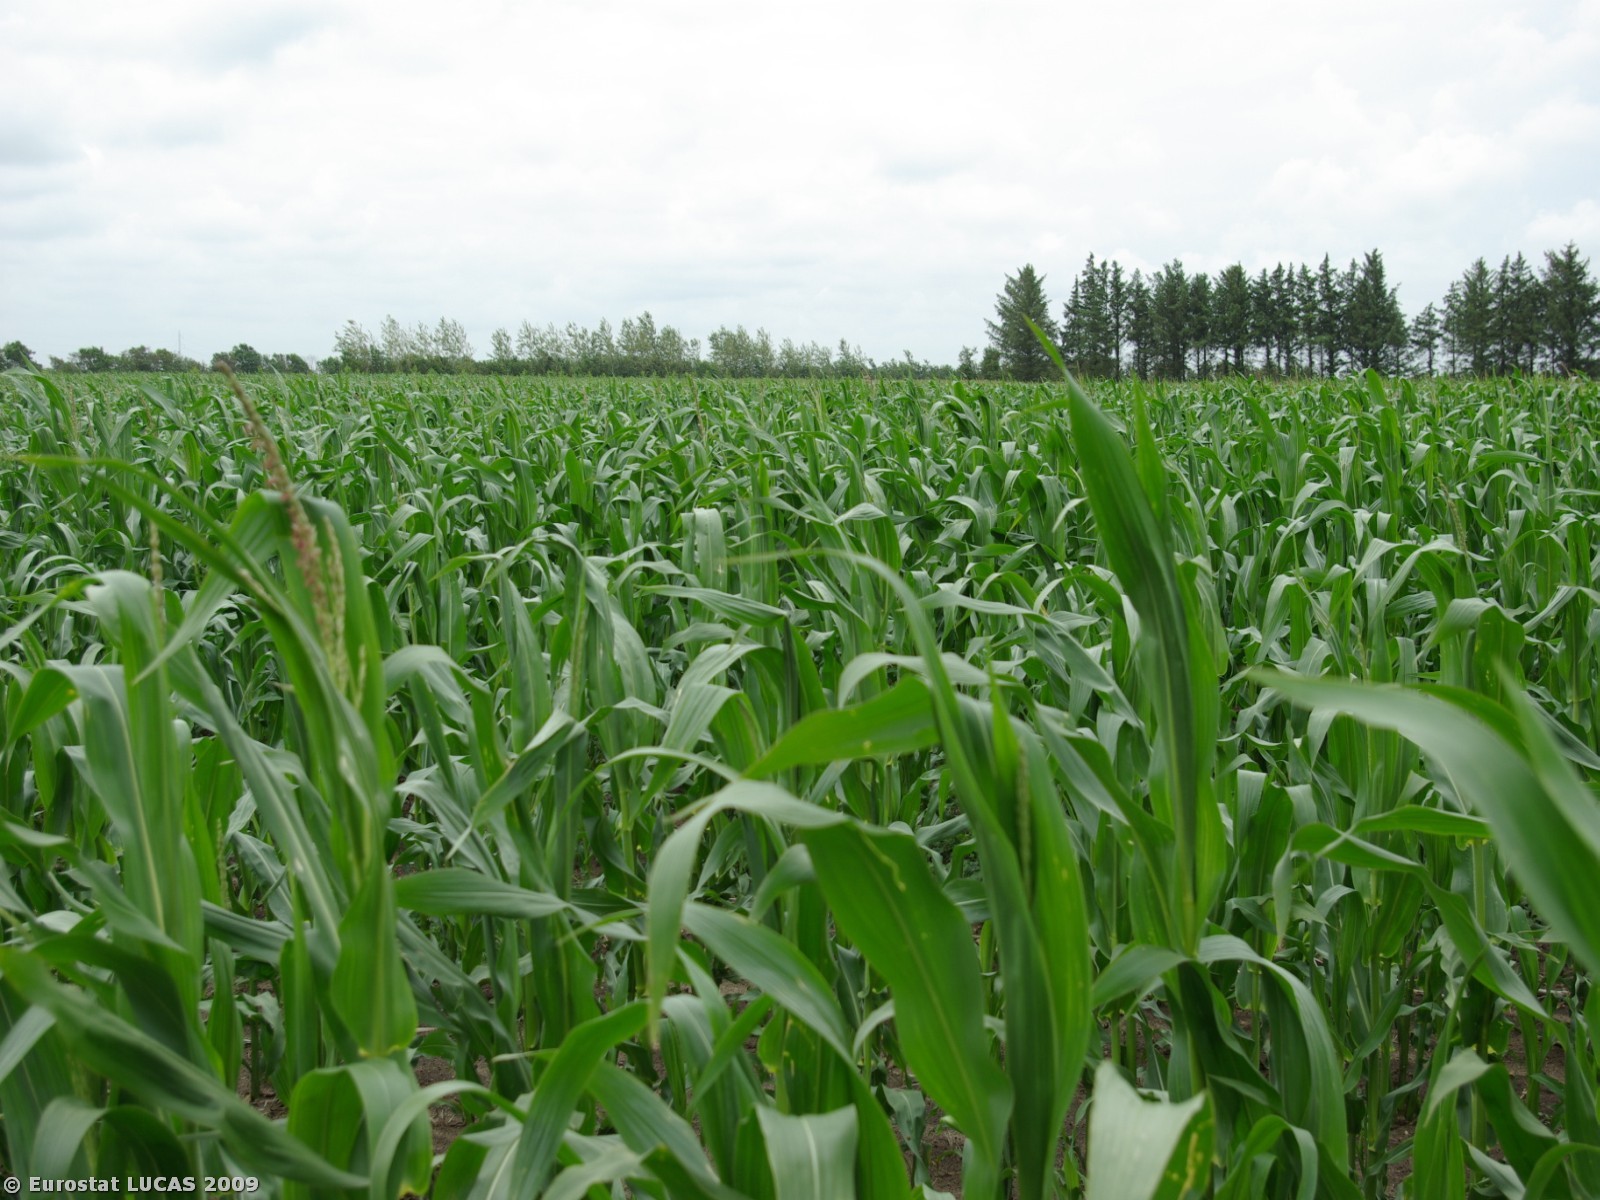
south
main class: Cropland
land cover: Maize
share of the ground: 50 - 75 %
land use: Agriculture (excluding fallow land and kitchen gardens)
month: July
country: DK
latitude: 55.0858
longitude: 8.8259
